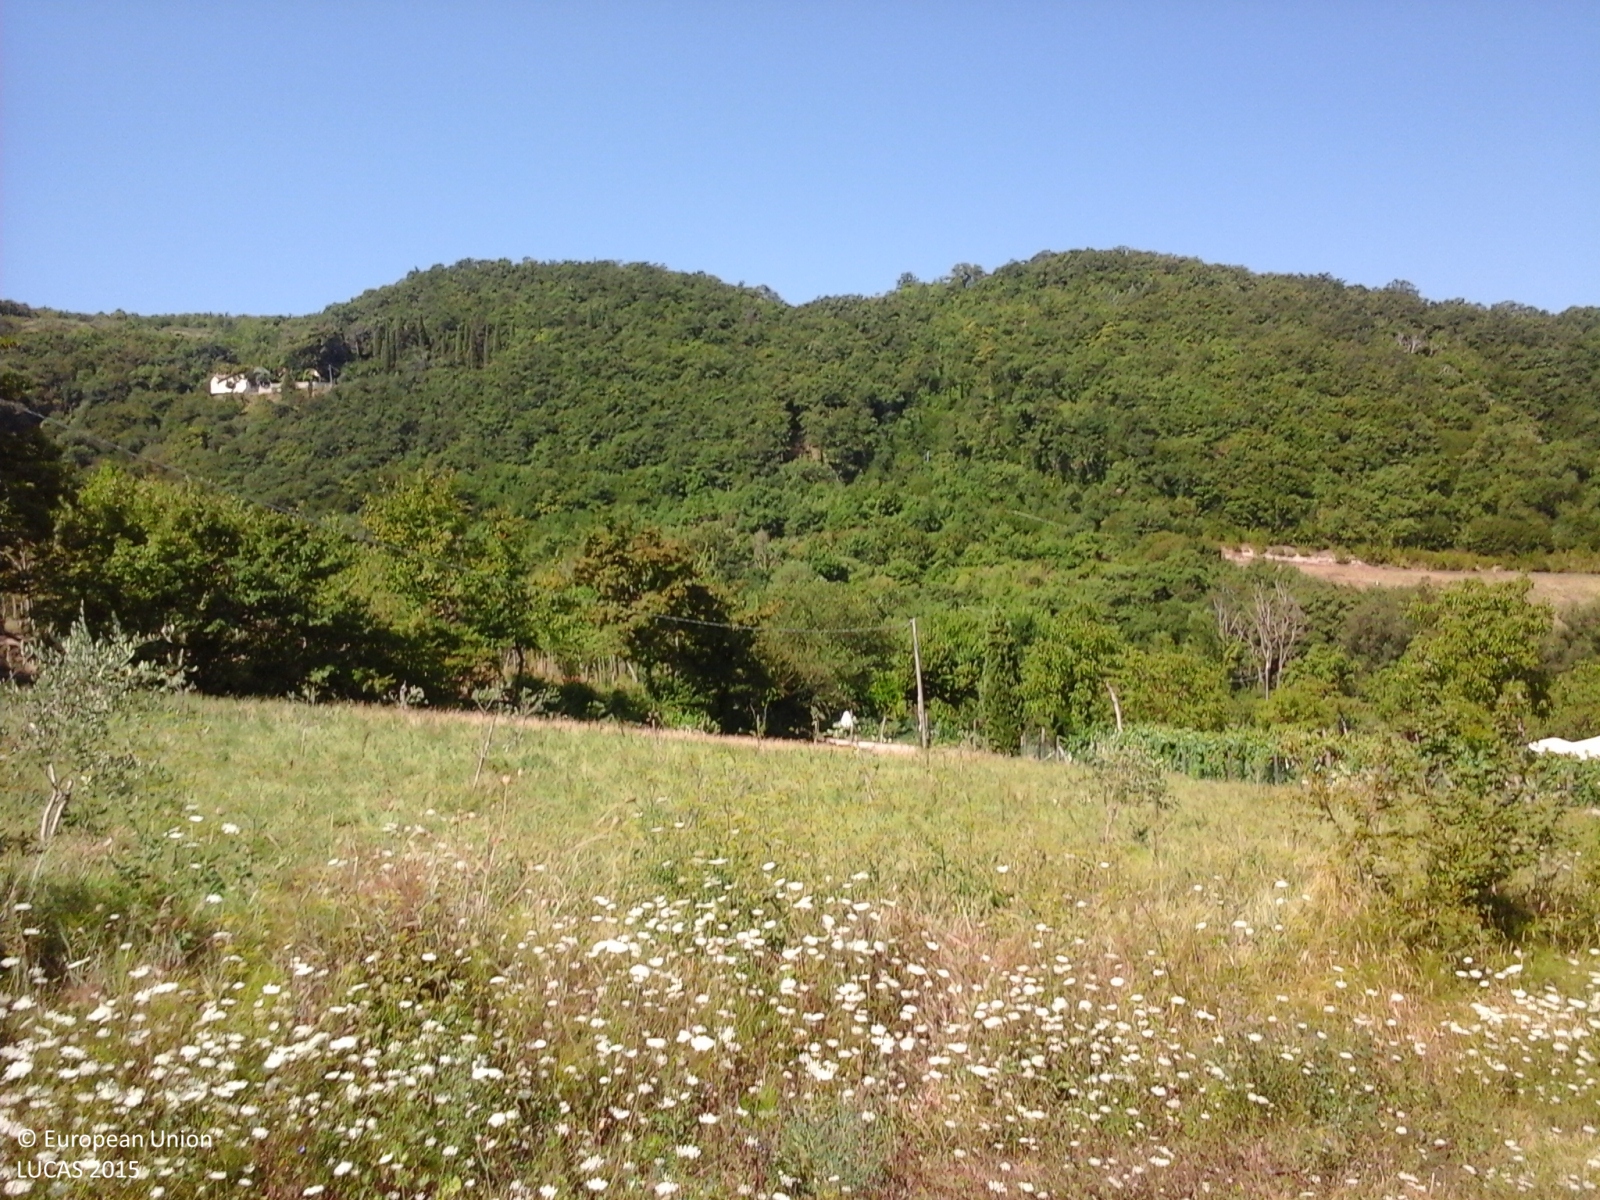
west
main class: Cropland
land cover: Lucerne
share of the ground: > 75 %
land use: Agriculture (excluding fallow land and kitchen gardens)
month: August
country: IT
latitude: 43.4608
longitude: 12.2064
